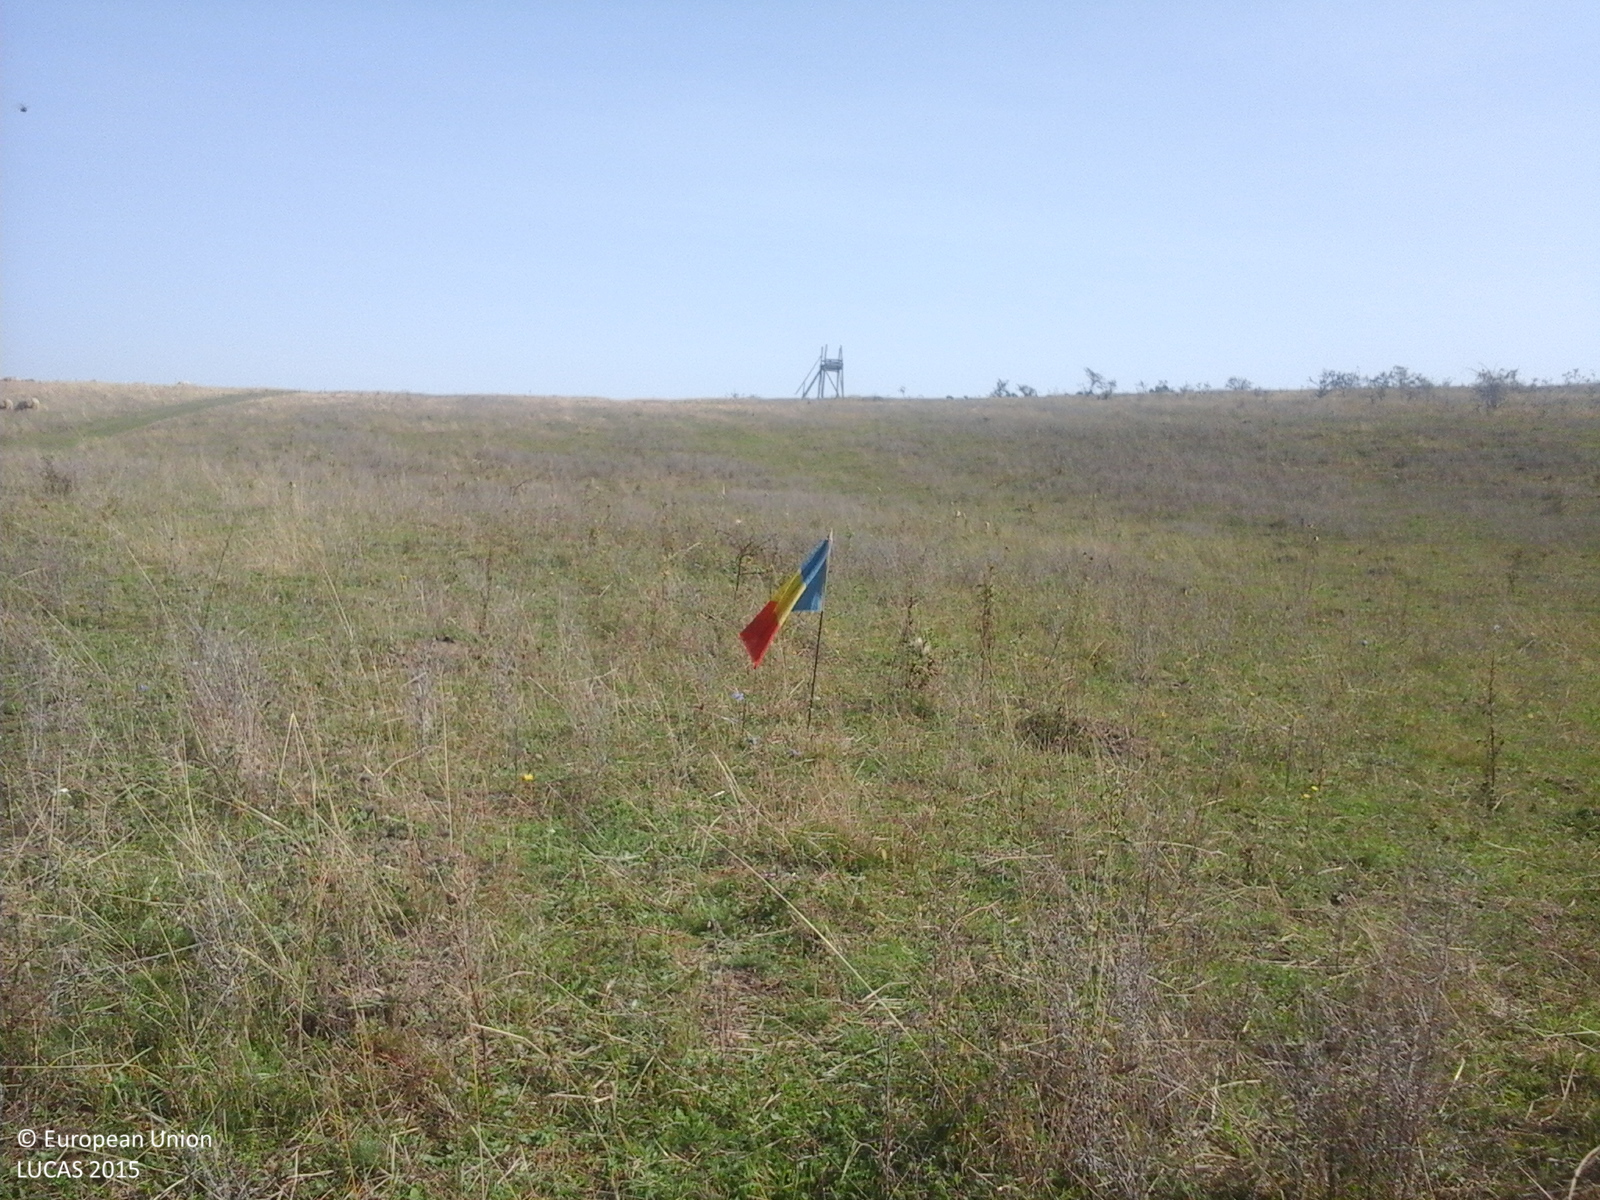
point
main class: Grassland
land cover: Grassland without tree/shrub cover
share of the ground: > 75 %
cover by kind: herbaceous plants 100 %
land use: Agriculture (excluding fallow land and kitchen gardens)
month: September
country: RO
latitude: 47.0893
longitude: 23.8435
